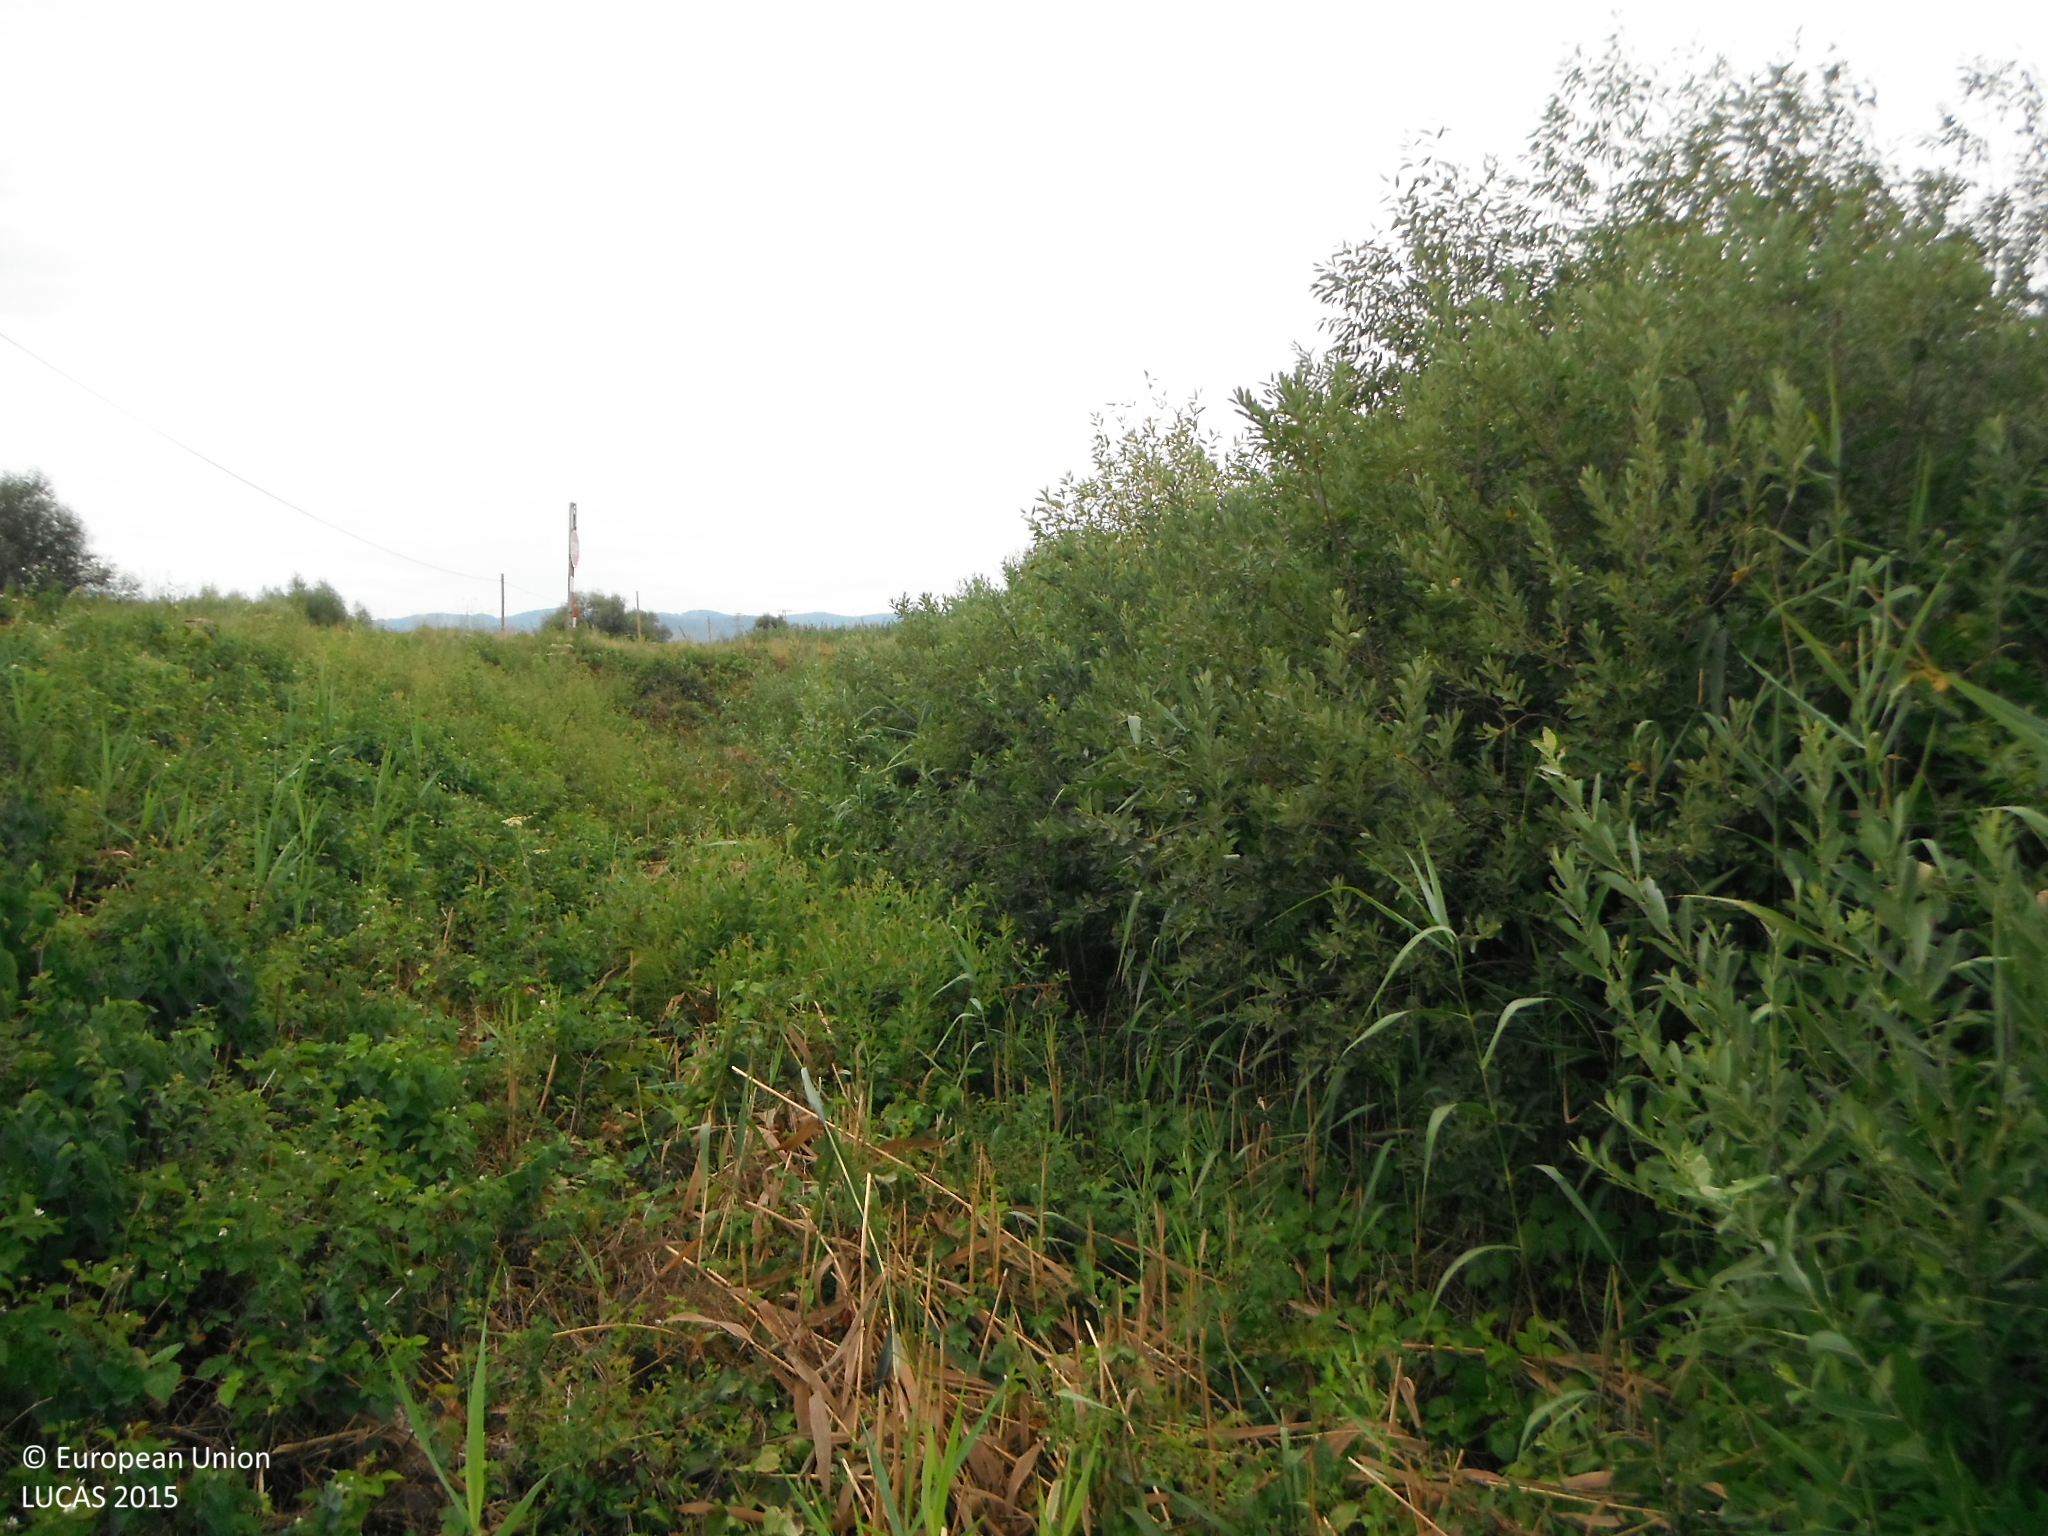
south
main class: Shrubland
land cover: Shrubland with sparse tree cover
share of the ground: > 75 %
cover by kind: shrubs 95 %, broadleaved forest trees 5 %
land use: Semi-natural and natural areas not in use
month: July
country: SK
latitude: 48.6352
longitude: 18.2796
